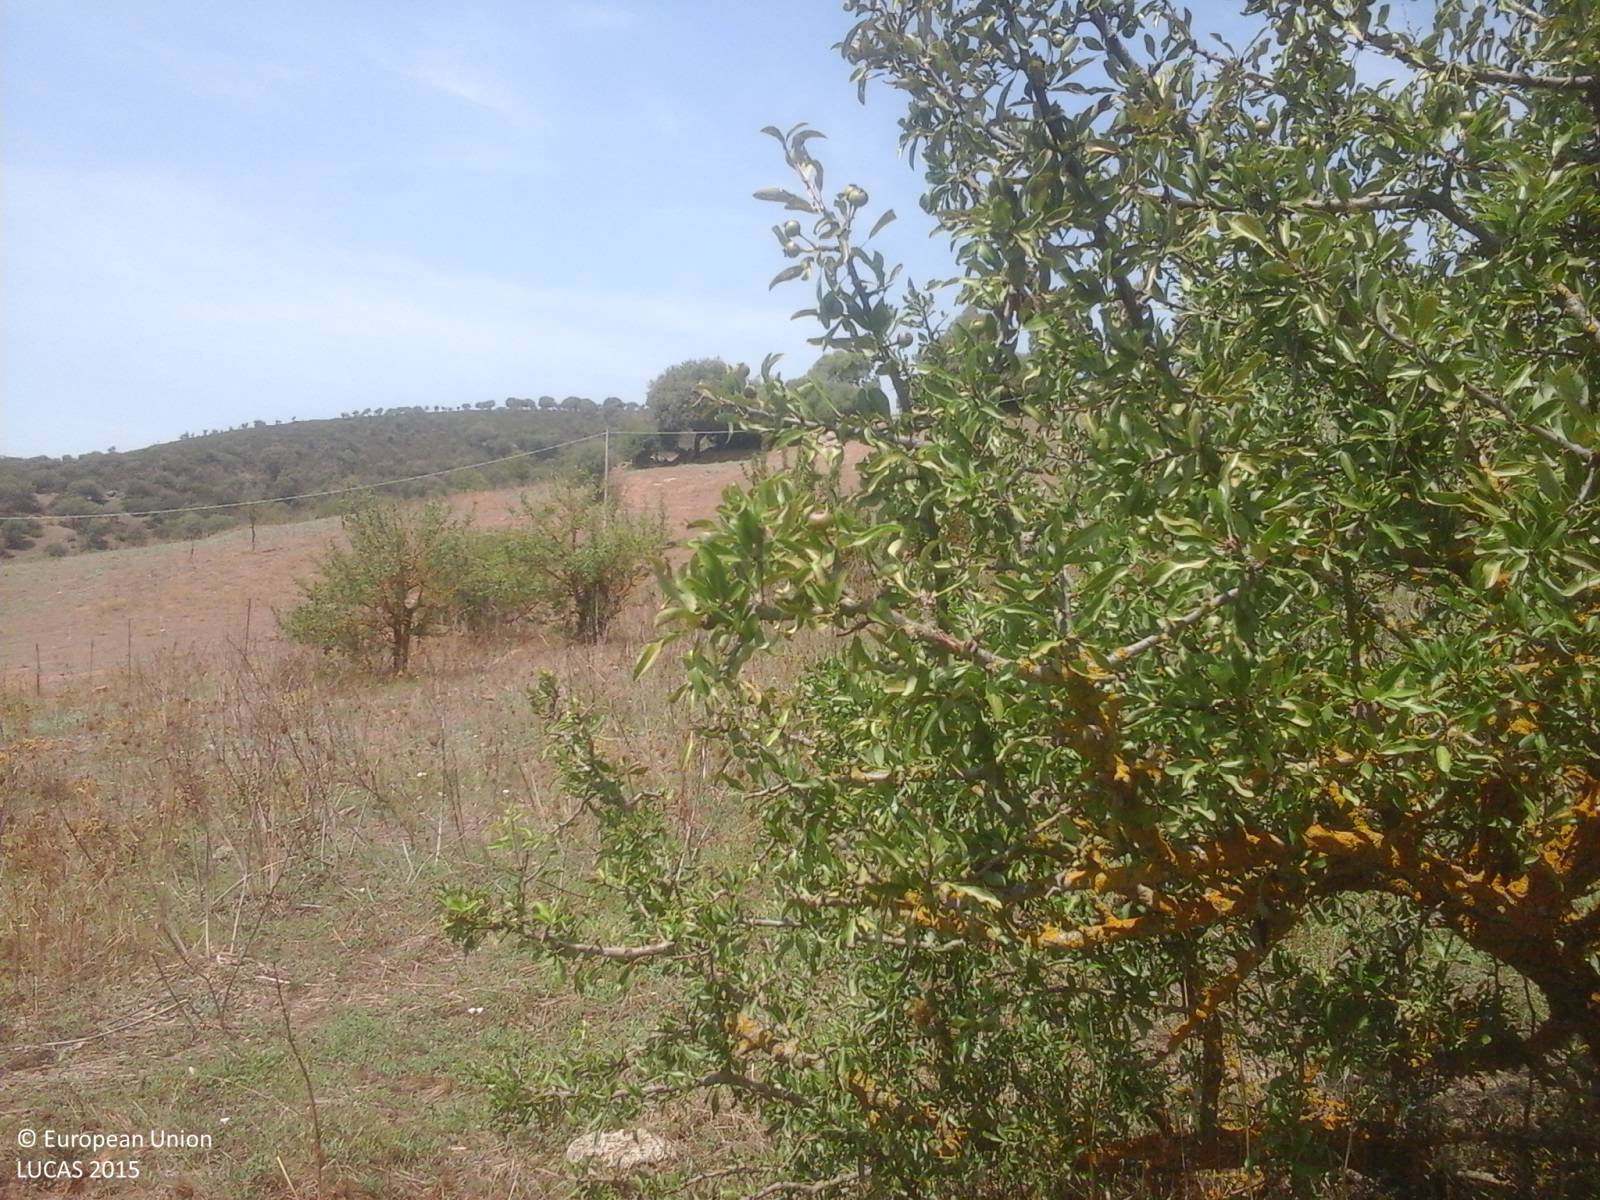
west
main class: Grassland
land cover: Grassland with sparse tree/shrub cover
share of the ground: > 75 %
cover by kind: herbaceous plants 70 %, unconsolidated bare surface 15 %, shrubs 10 %, broadleaved forest trees 5 %
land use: Agriculture (excluding fallow land and kitchen gardens)
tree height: < 5 m
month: August
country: IT
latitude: 39.6484
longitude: 9.2005
